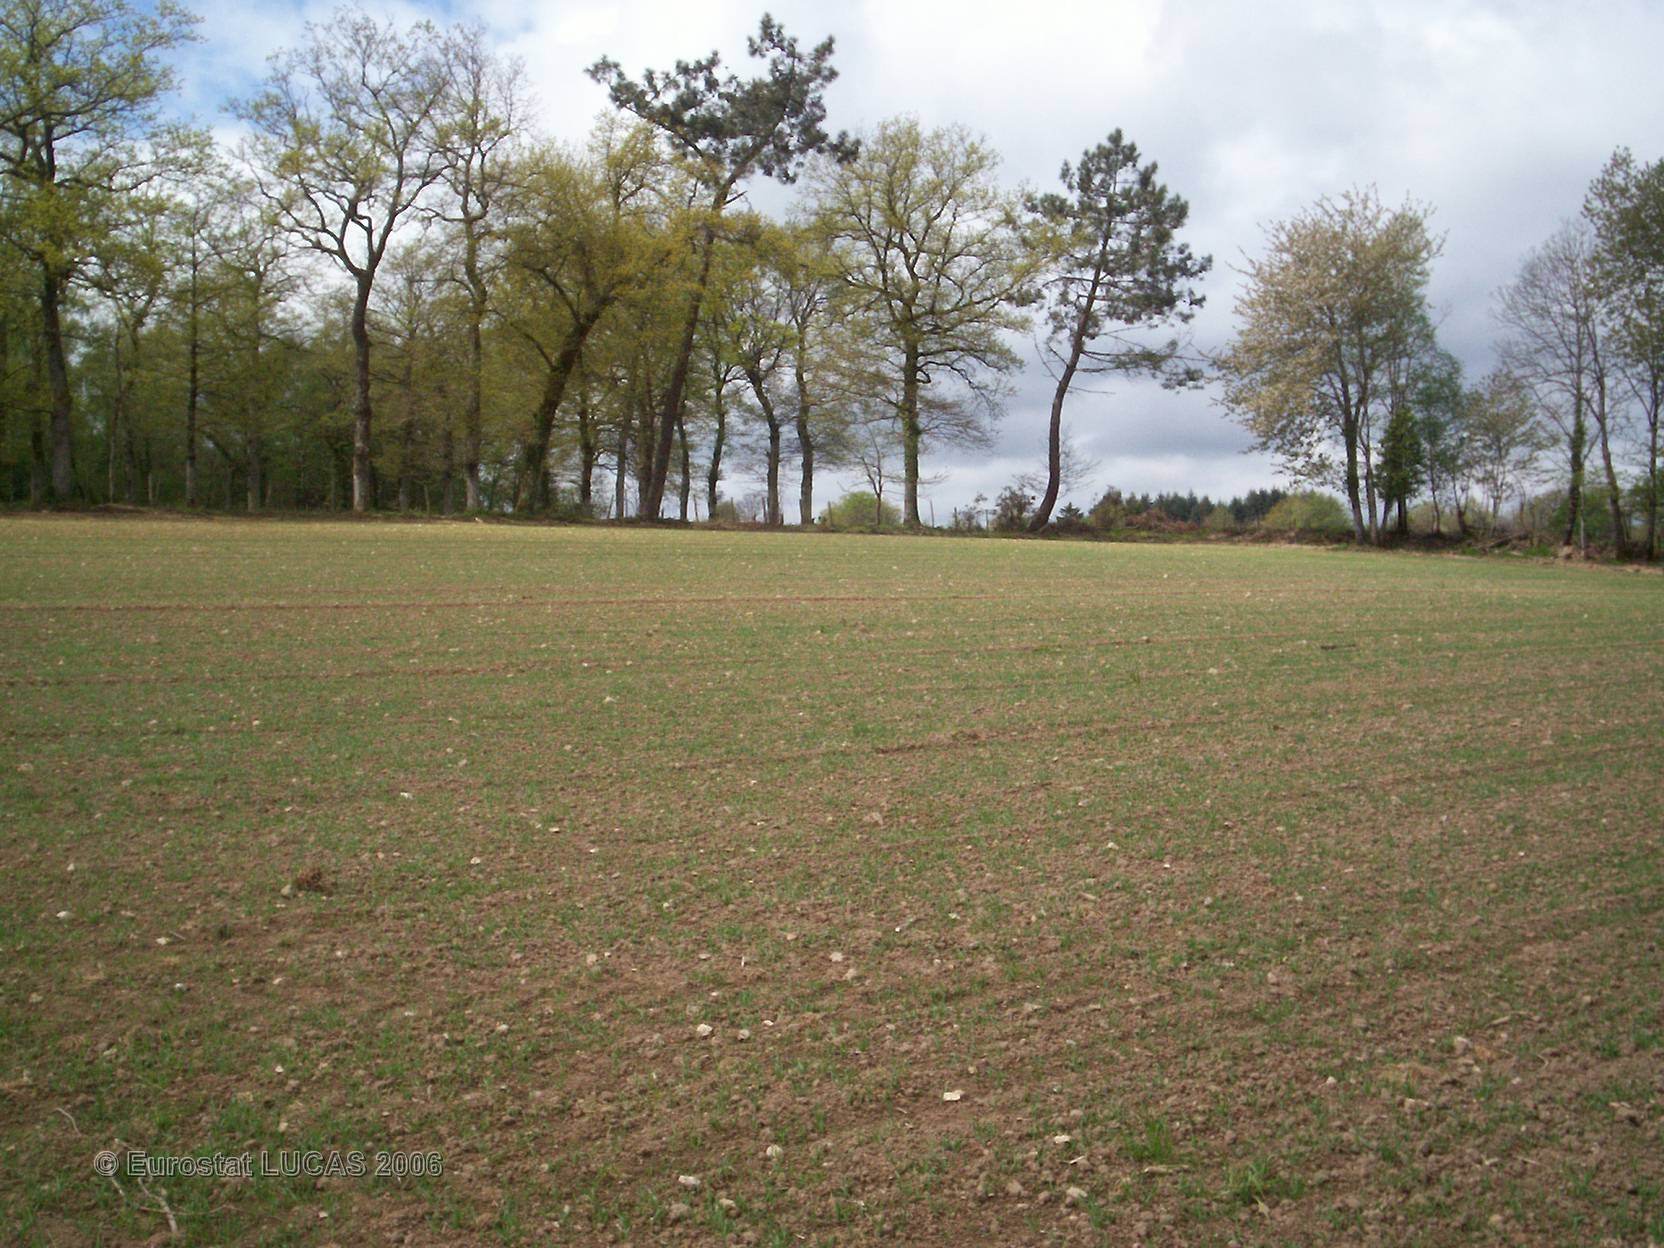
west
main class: Cropland
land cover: Common wheat
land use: Agriculture (excluding fallow land and kitchen gardens)
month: April
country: FR
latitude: 45.7476
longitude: 0.7197
